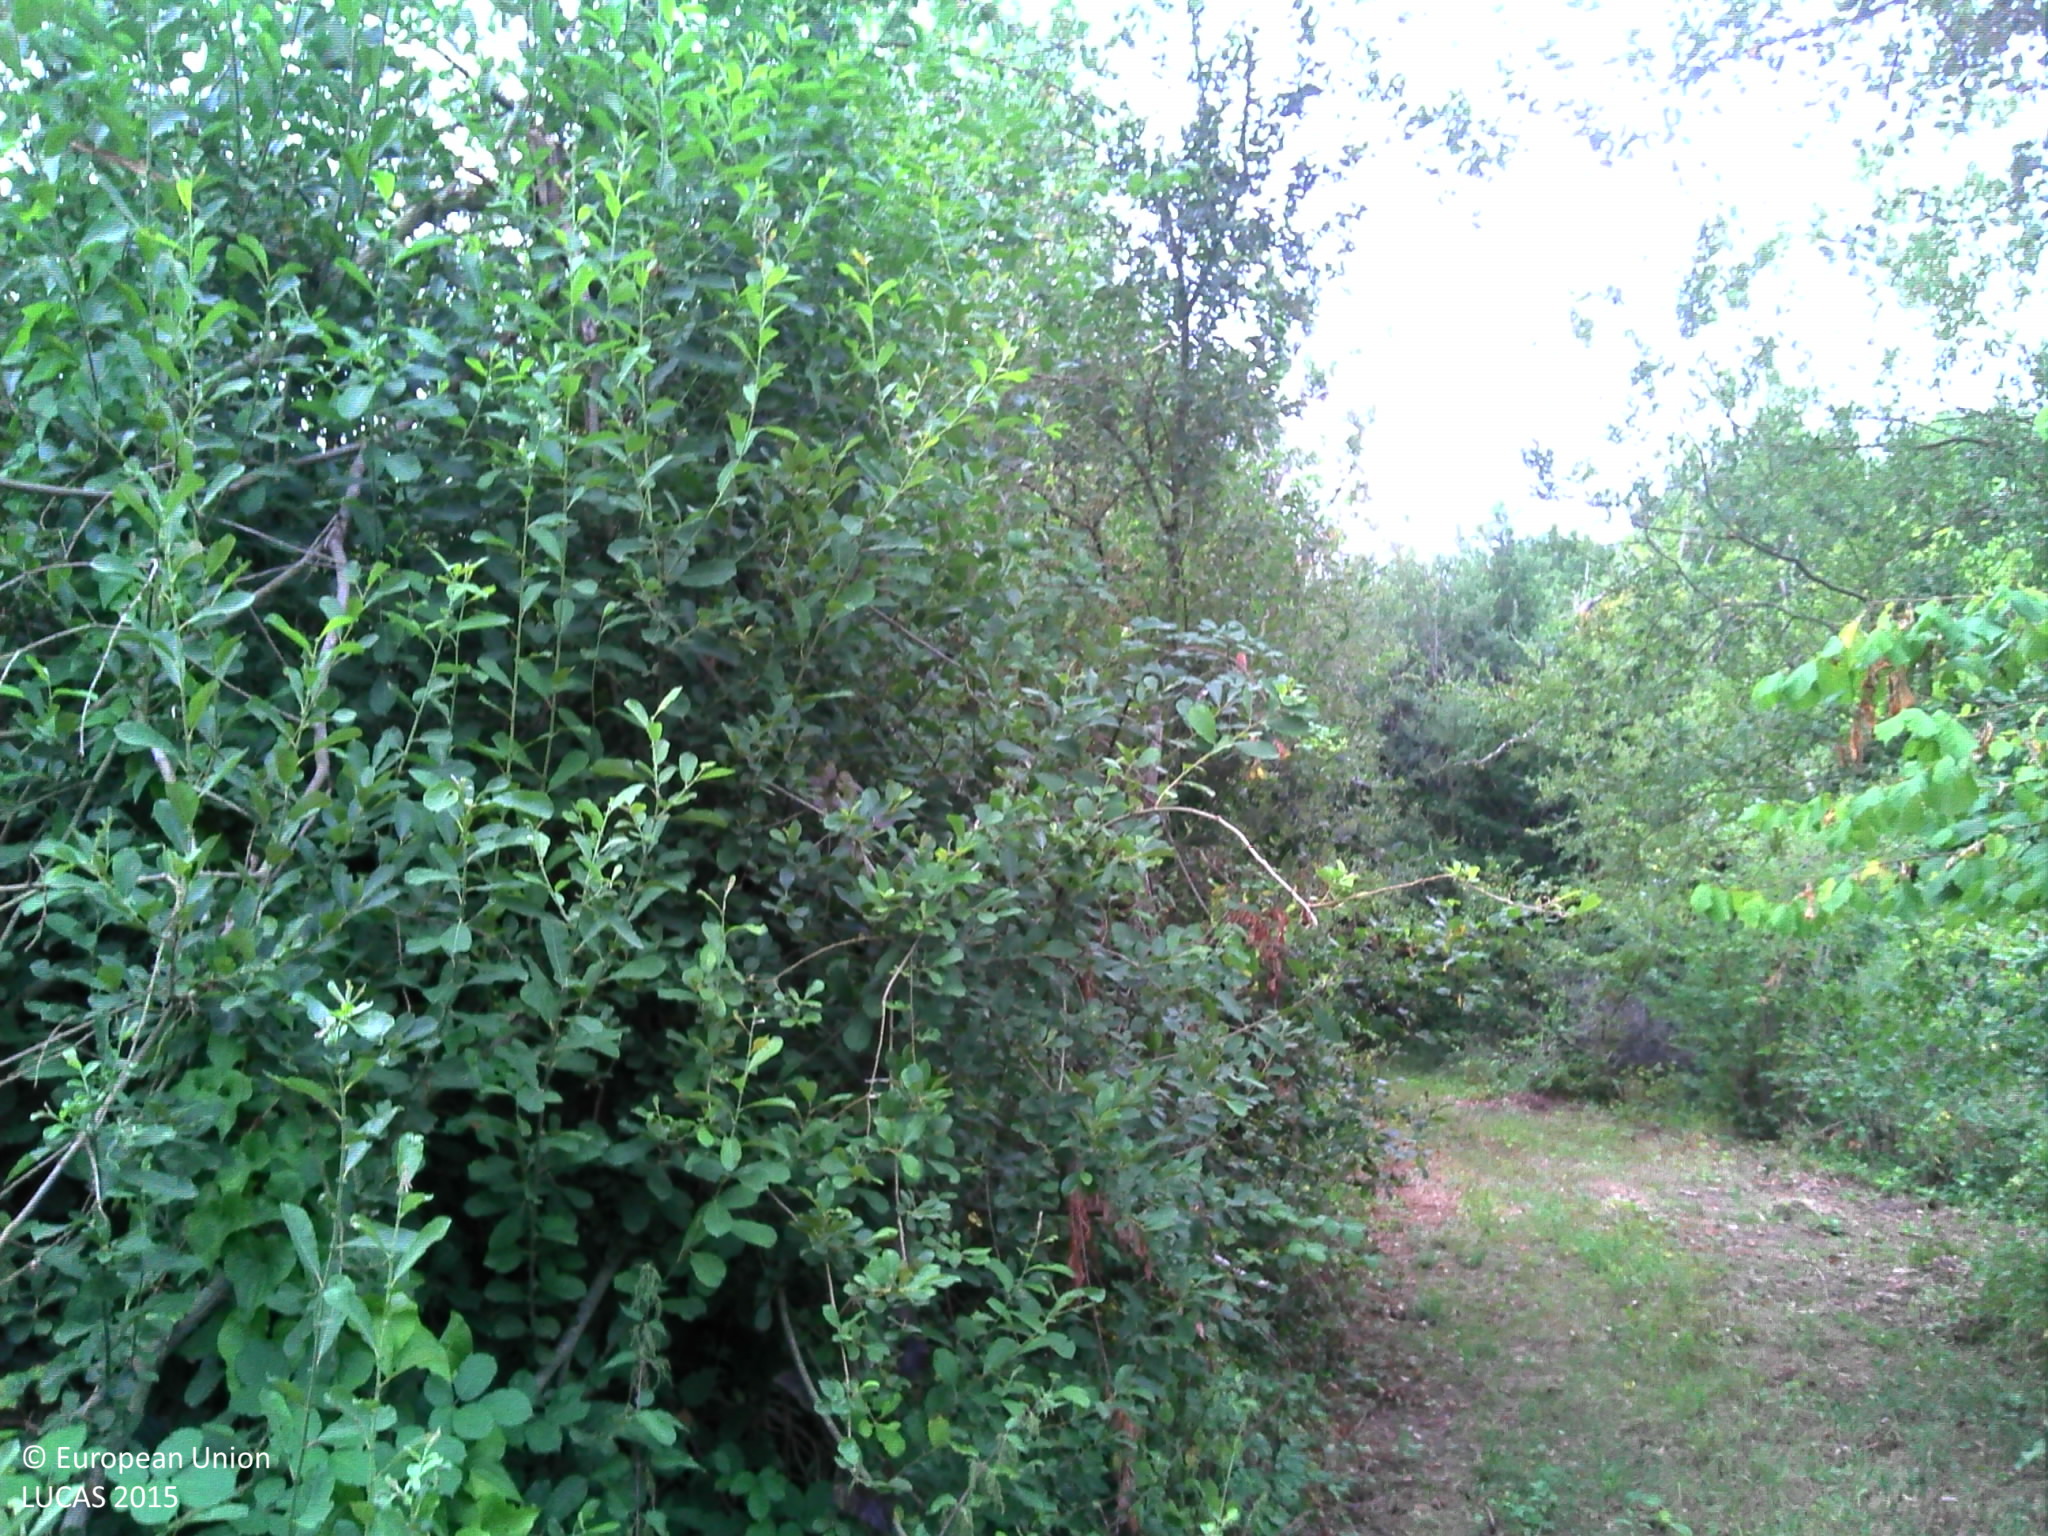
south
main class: Woodland
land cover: Pine dominated coniferous woodland
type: exotic forest
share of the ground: > 75 %
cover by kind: coniferous forest trees 75 %, broadleaved forest trees 10 %, herbaceous plants 10 %, shrubs 5 %
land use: Forestry
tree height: > 5 m
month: July
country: FR
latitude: 48.0944
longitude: 0.6188
